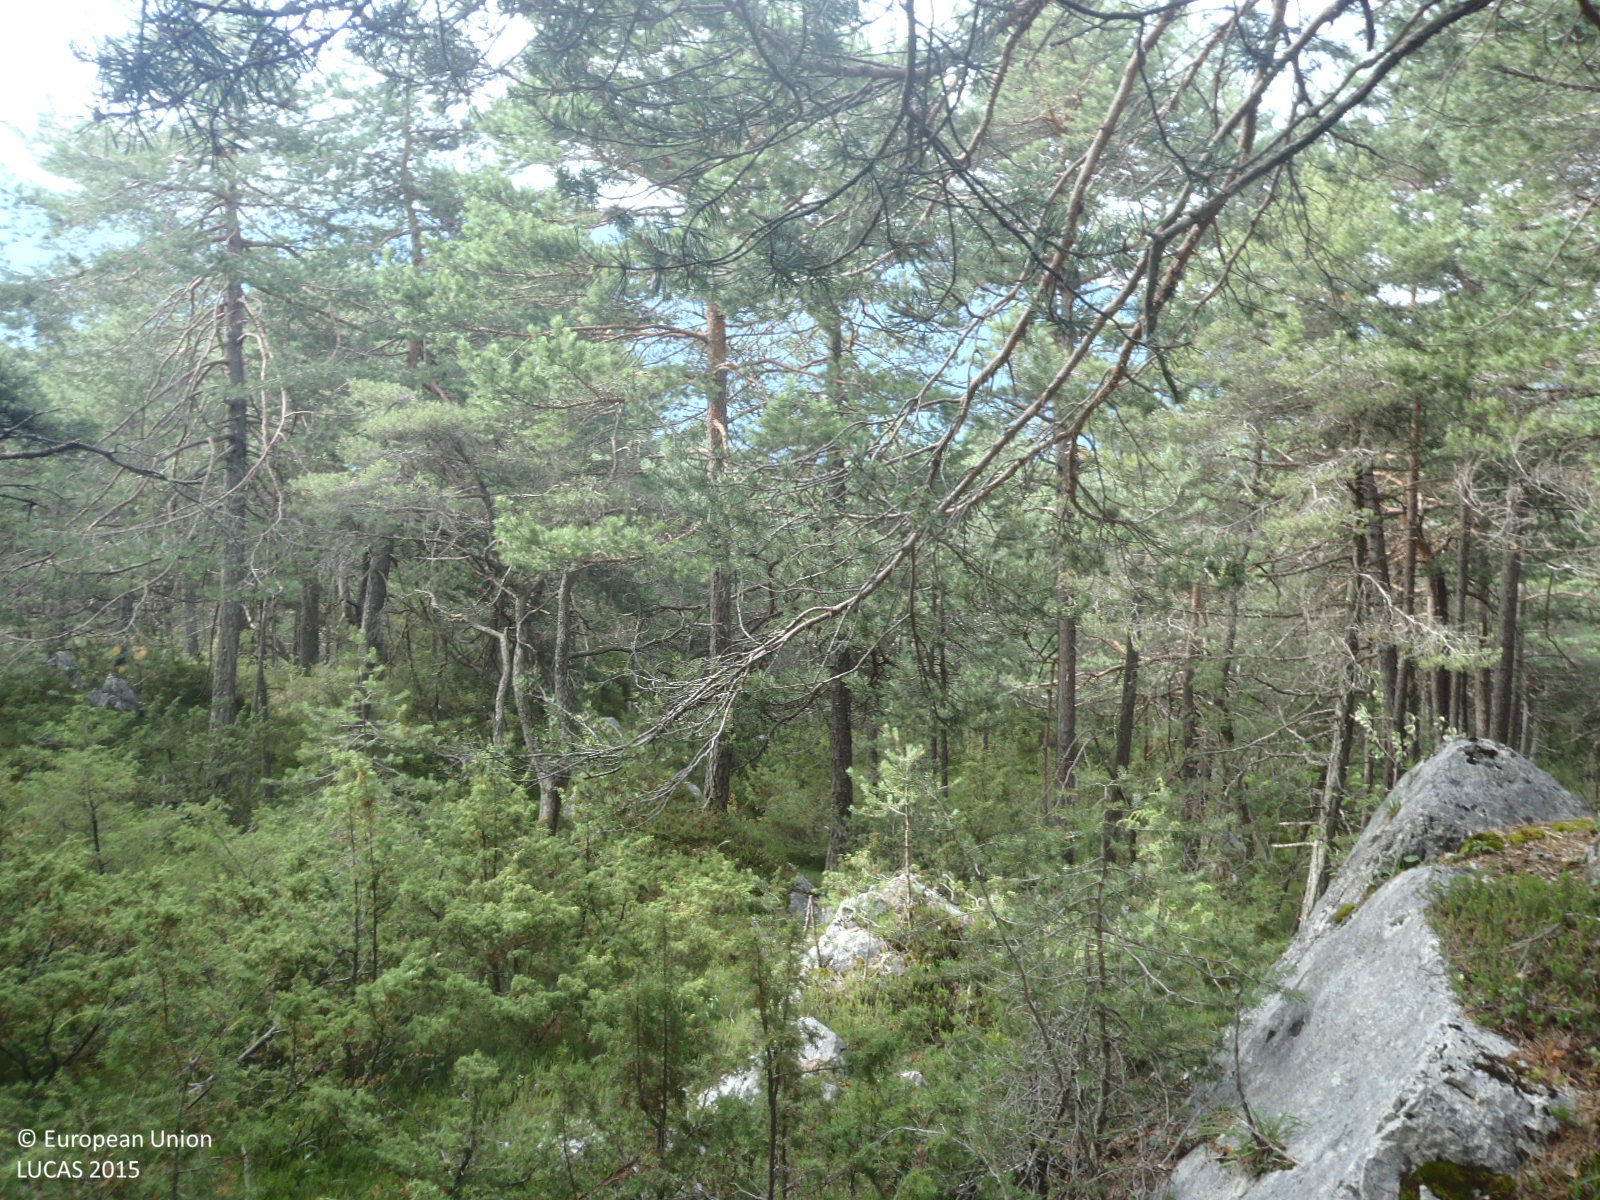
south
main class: Woodland
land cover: Pine dominated coniferous woodland
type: alpine coniferous forest
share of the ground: > 75 %
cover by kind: coniferous forest trees 80 %, shrubs 15 %, consolidated bare surface 5 %
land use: Semi-natural and natural areas not in use
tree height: > 5 m
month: July
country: AT
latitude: 47.3193
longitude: 10.9649
